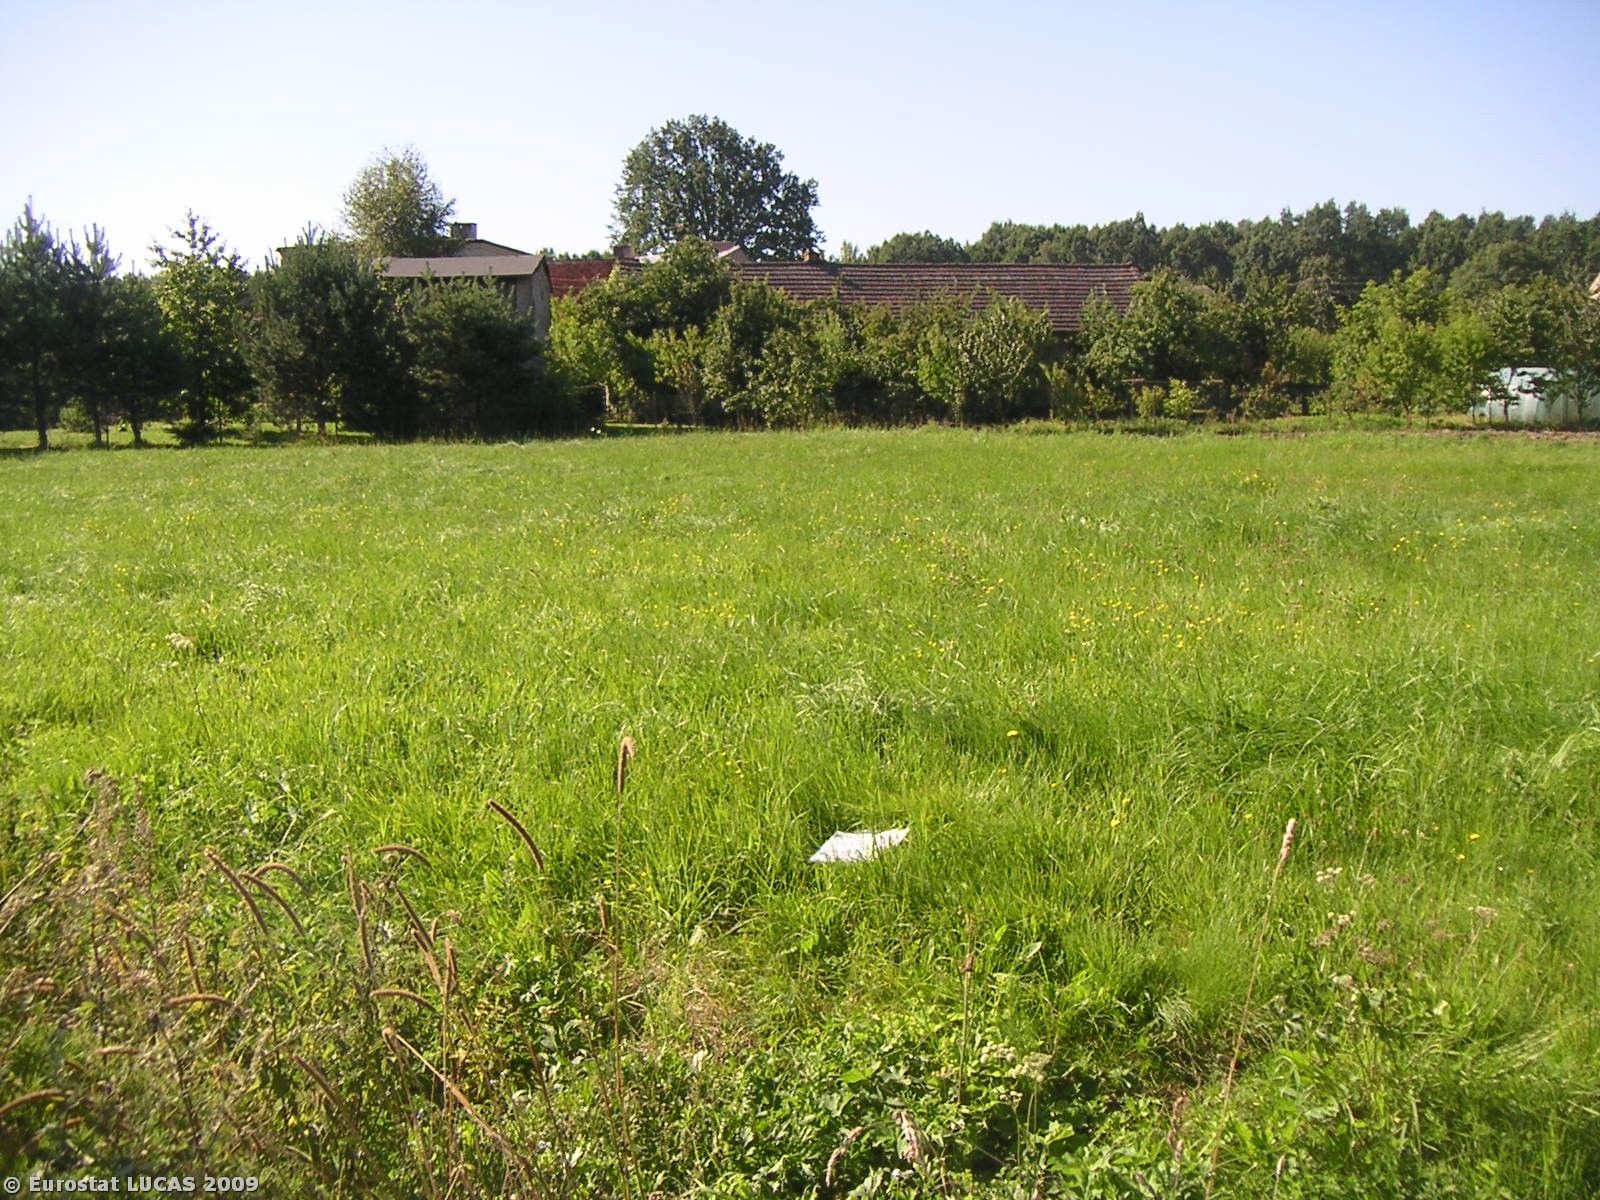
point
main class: Grassland
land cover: Grassland without tree/shrub cover
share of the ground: > 75 %
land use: Agriculture (excluding fallow land and kitchen gardens)
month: August
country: PL
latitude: 50.6927
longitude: 18.8127
